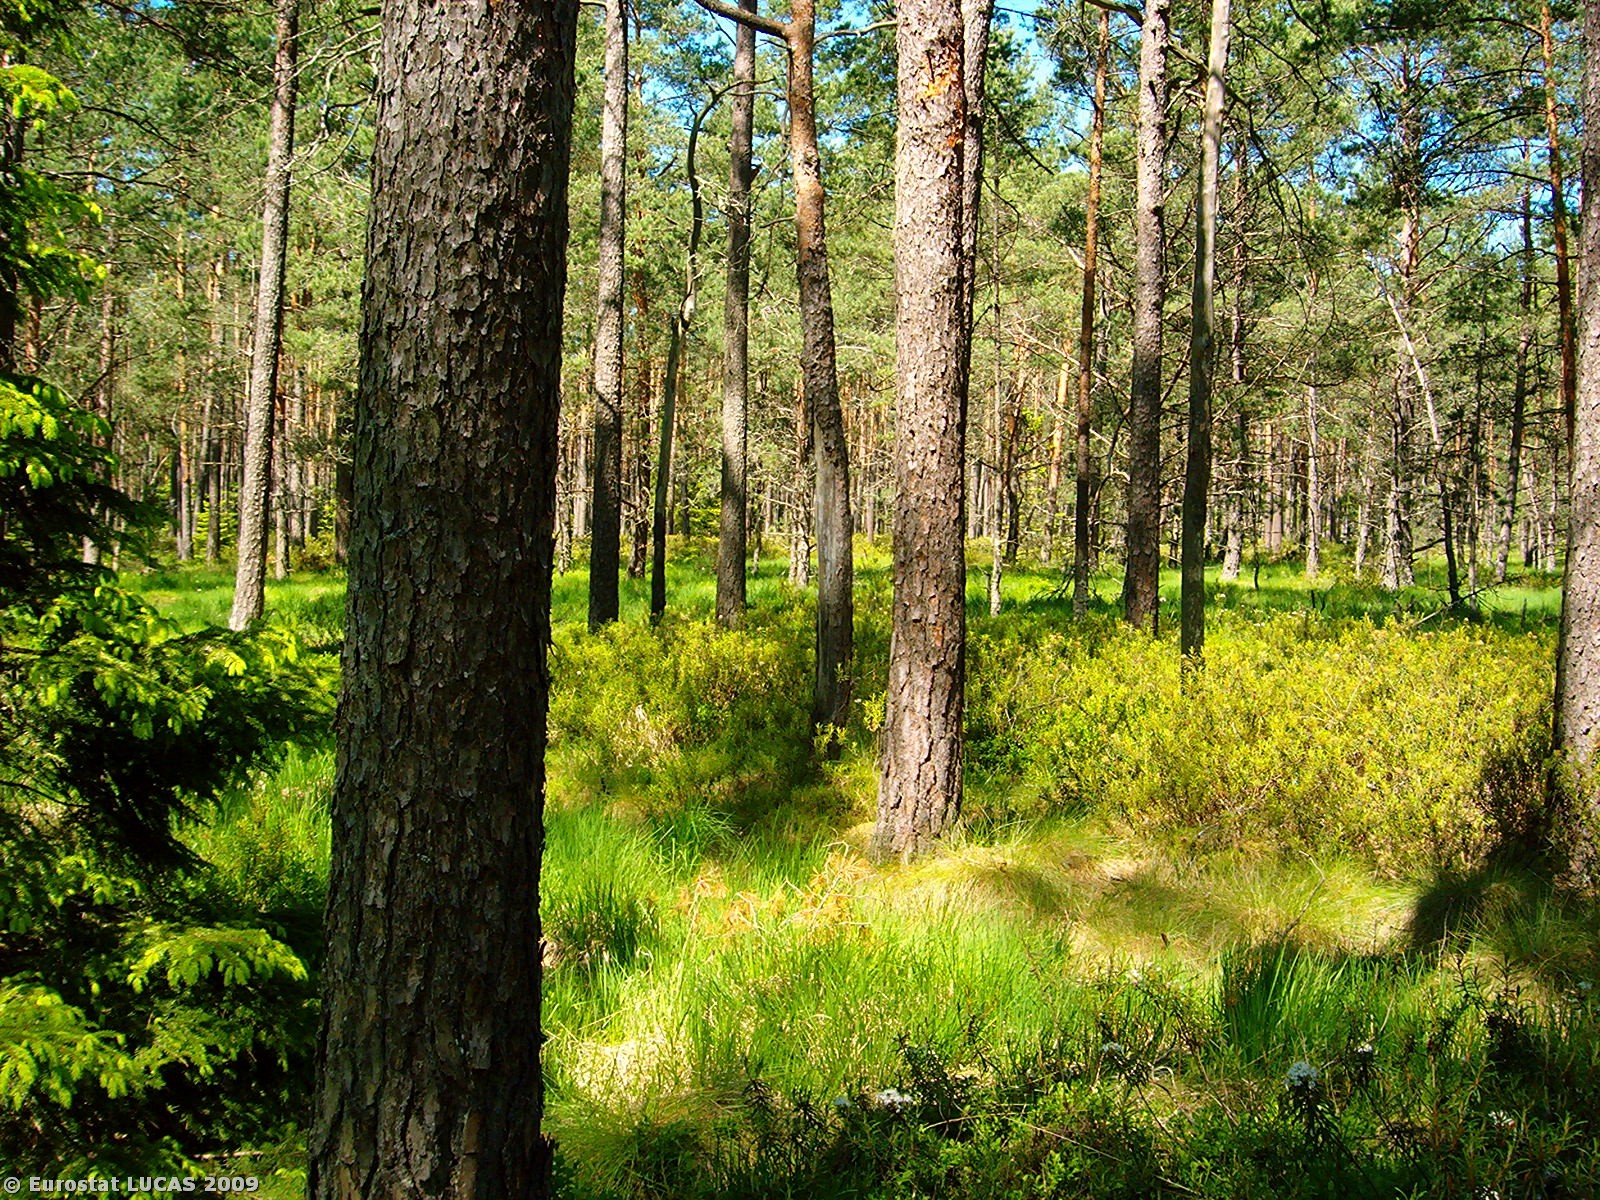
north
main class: Woodland
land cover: Coniferous woodland
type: hemiboreal forest and nemoral coniferous forest and mixed broadleaved-coniferous forest
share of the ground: 50 - 75 %
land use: Forestry
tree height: > 5 m
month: June
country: PL
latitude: 53.9089
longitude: 17.2099
